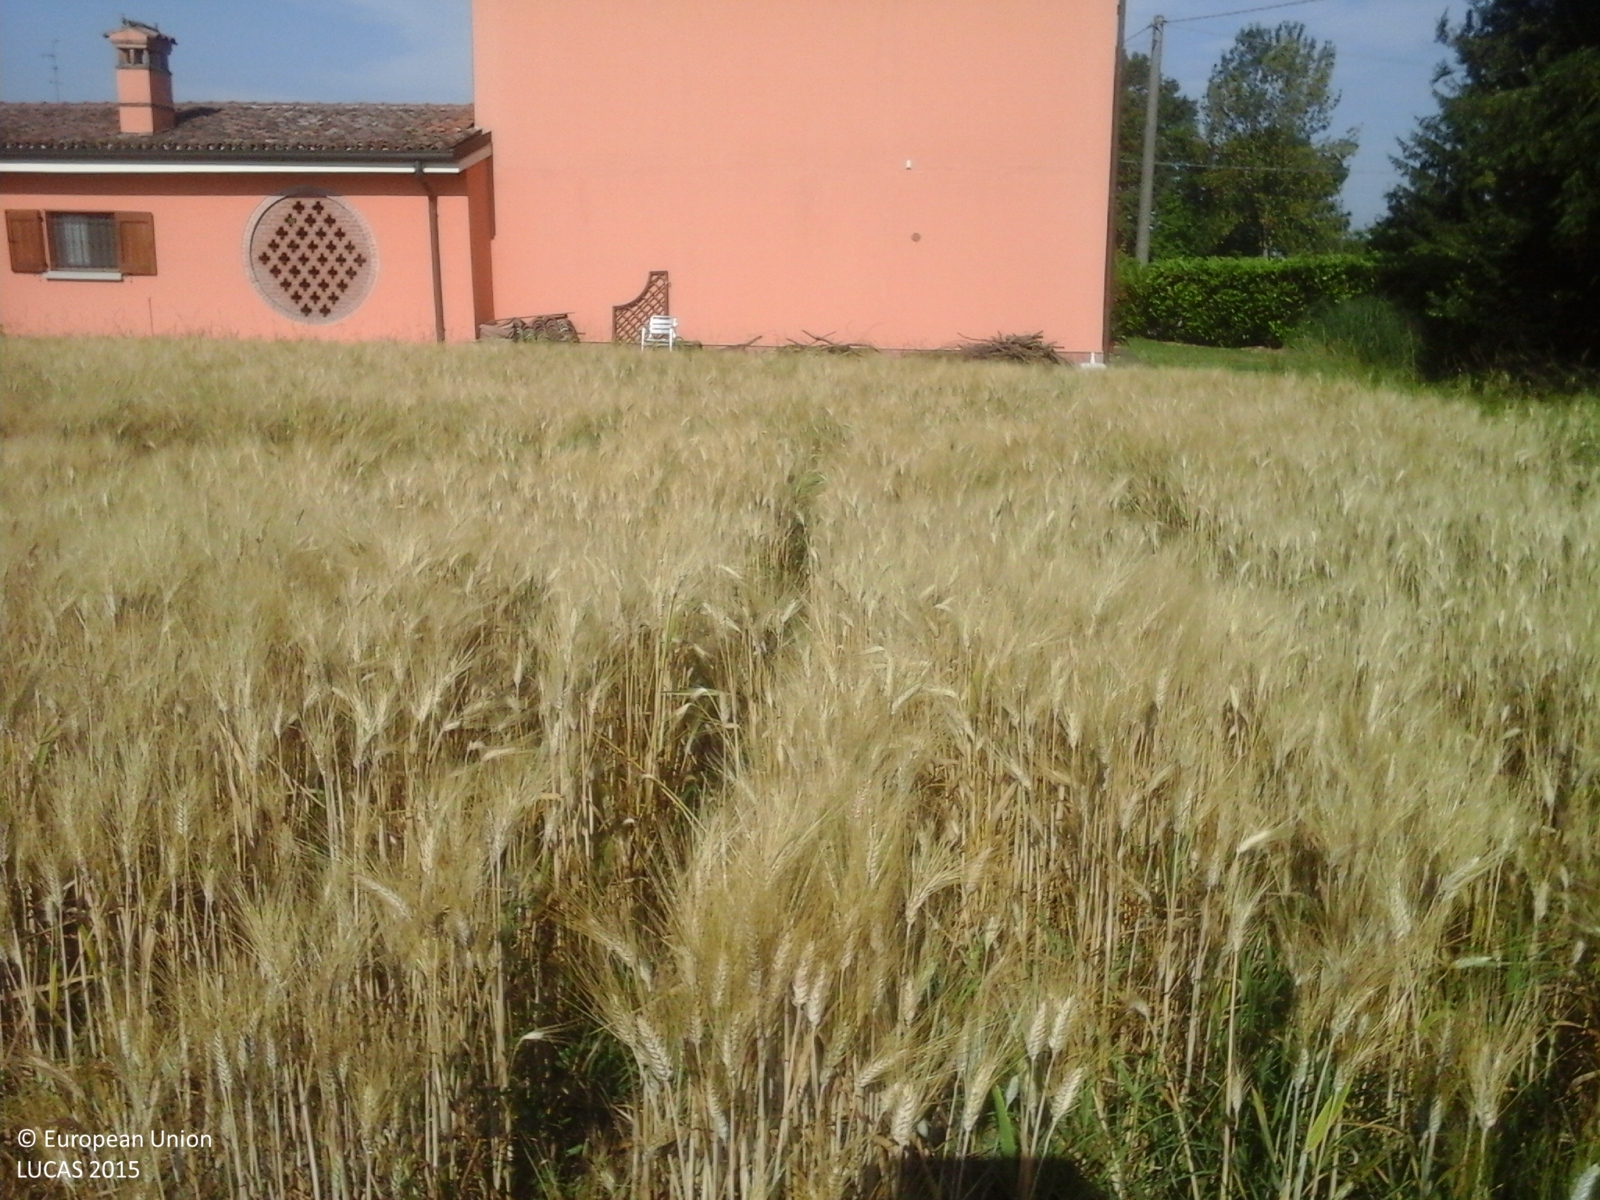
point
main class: Cropland
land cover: Common wheat
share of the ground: > 75 %
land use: Agriculture (excluding fallow land and kitchen gardens)
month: June
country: IT
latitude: 44.8875
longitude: 10.9224
